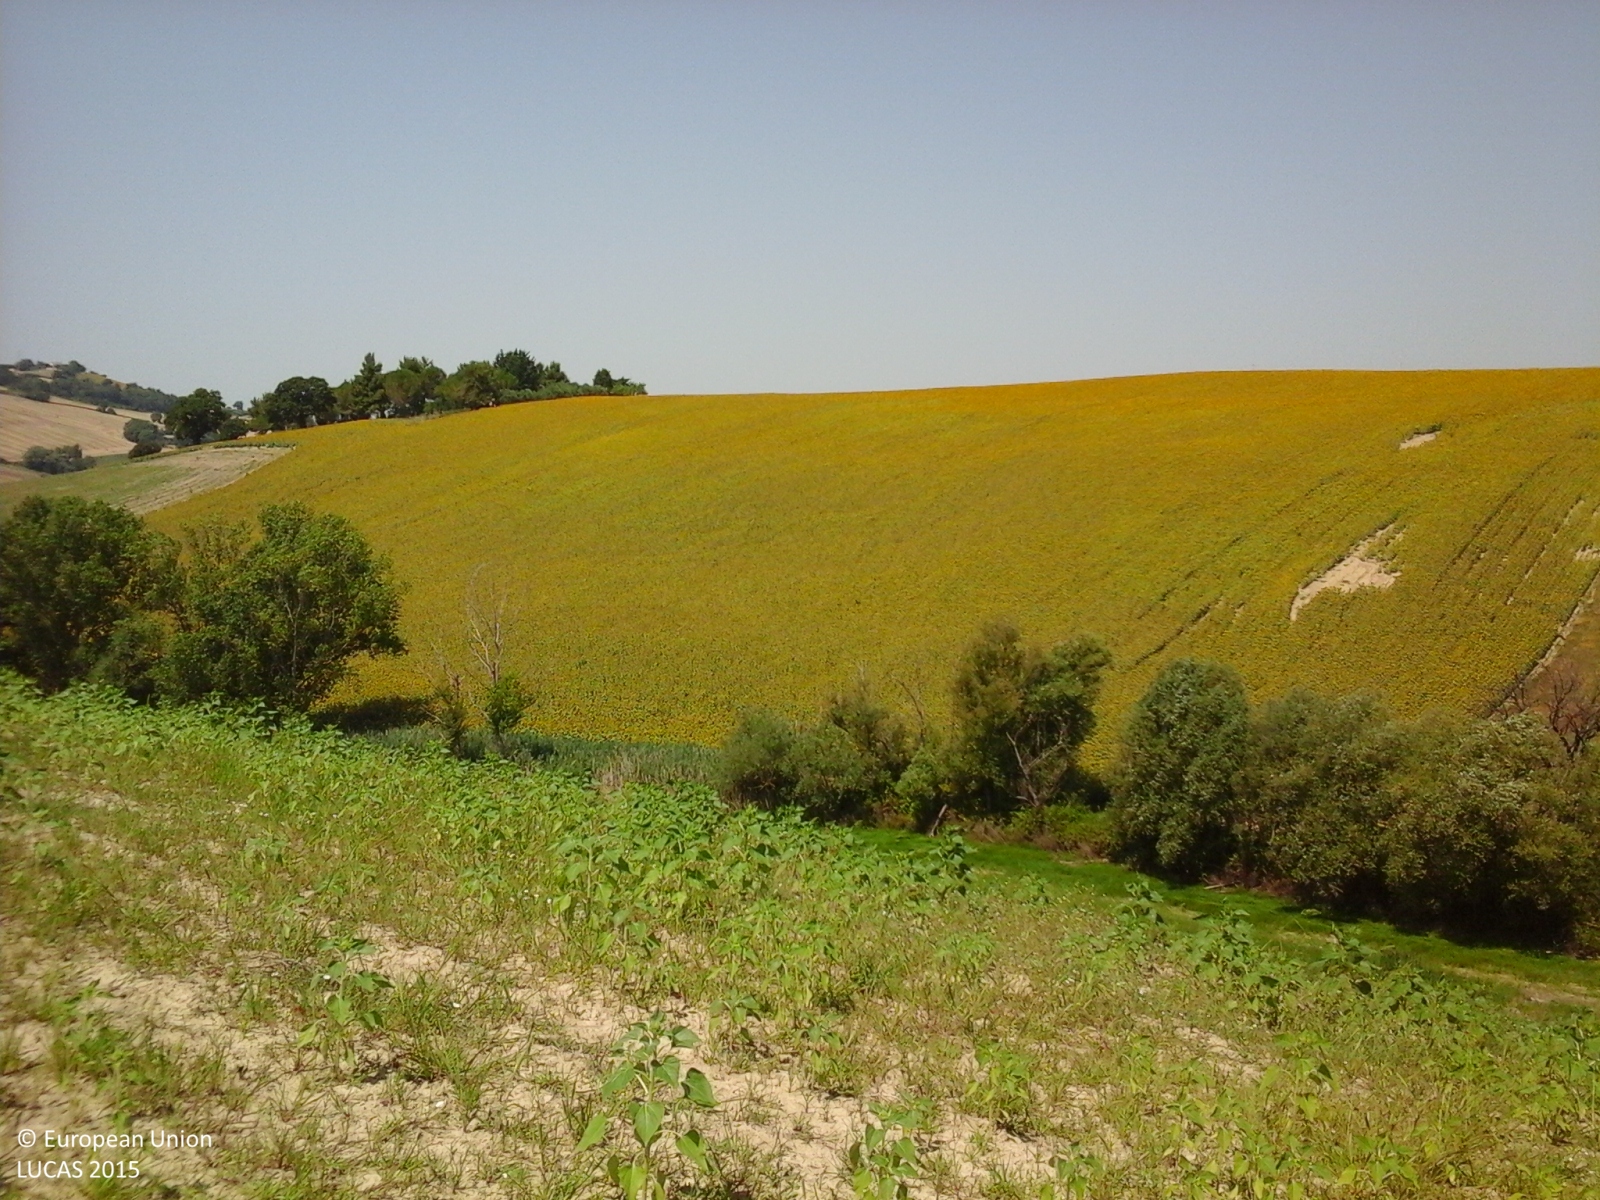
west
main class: Cropland
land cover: Sunflower
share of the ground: 25 - 50 %
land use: Agriculture (excluding fallow land and kitchen gardens)
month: July
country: IT
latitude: 43.3900
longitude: 13.4603
